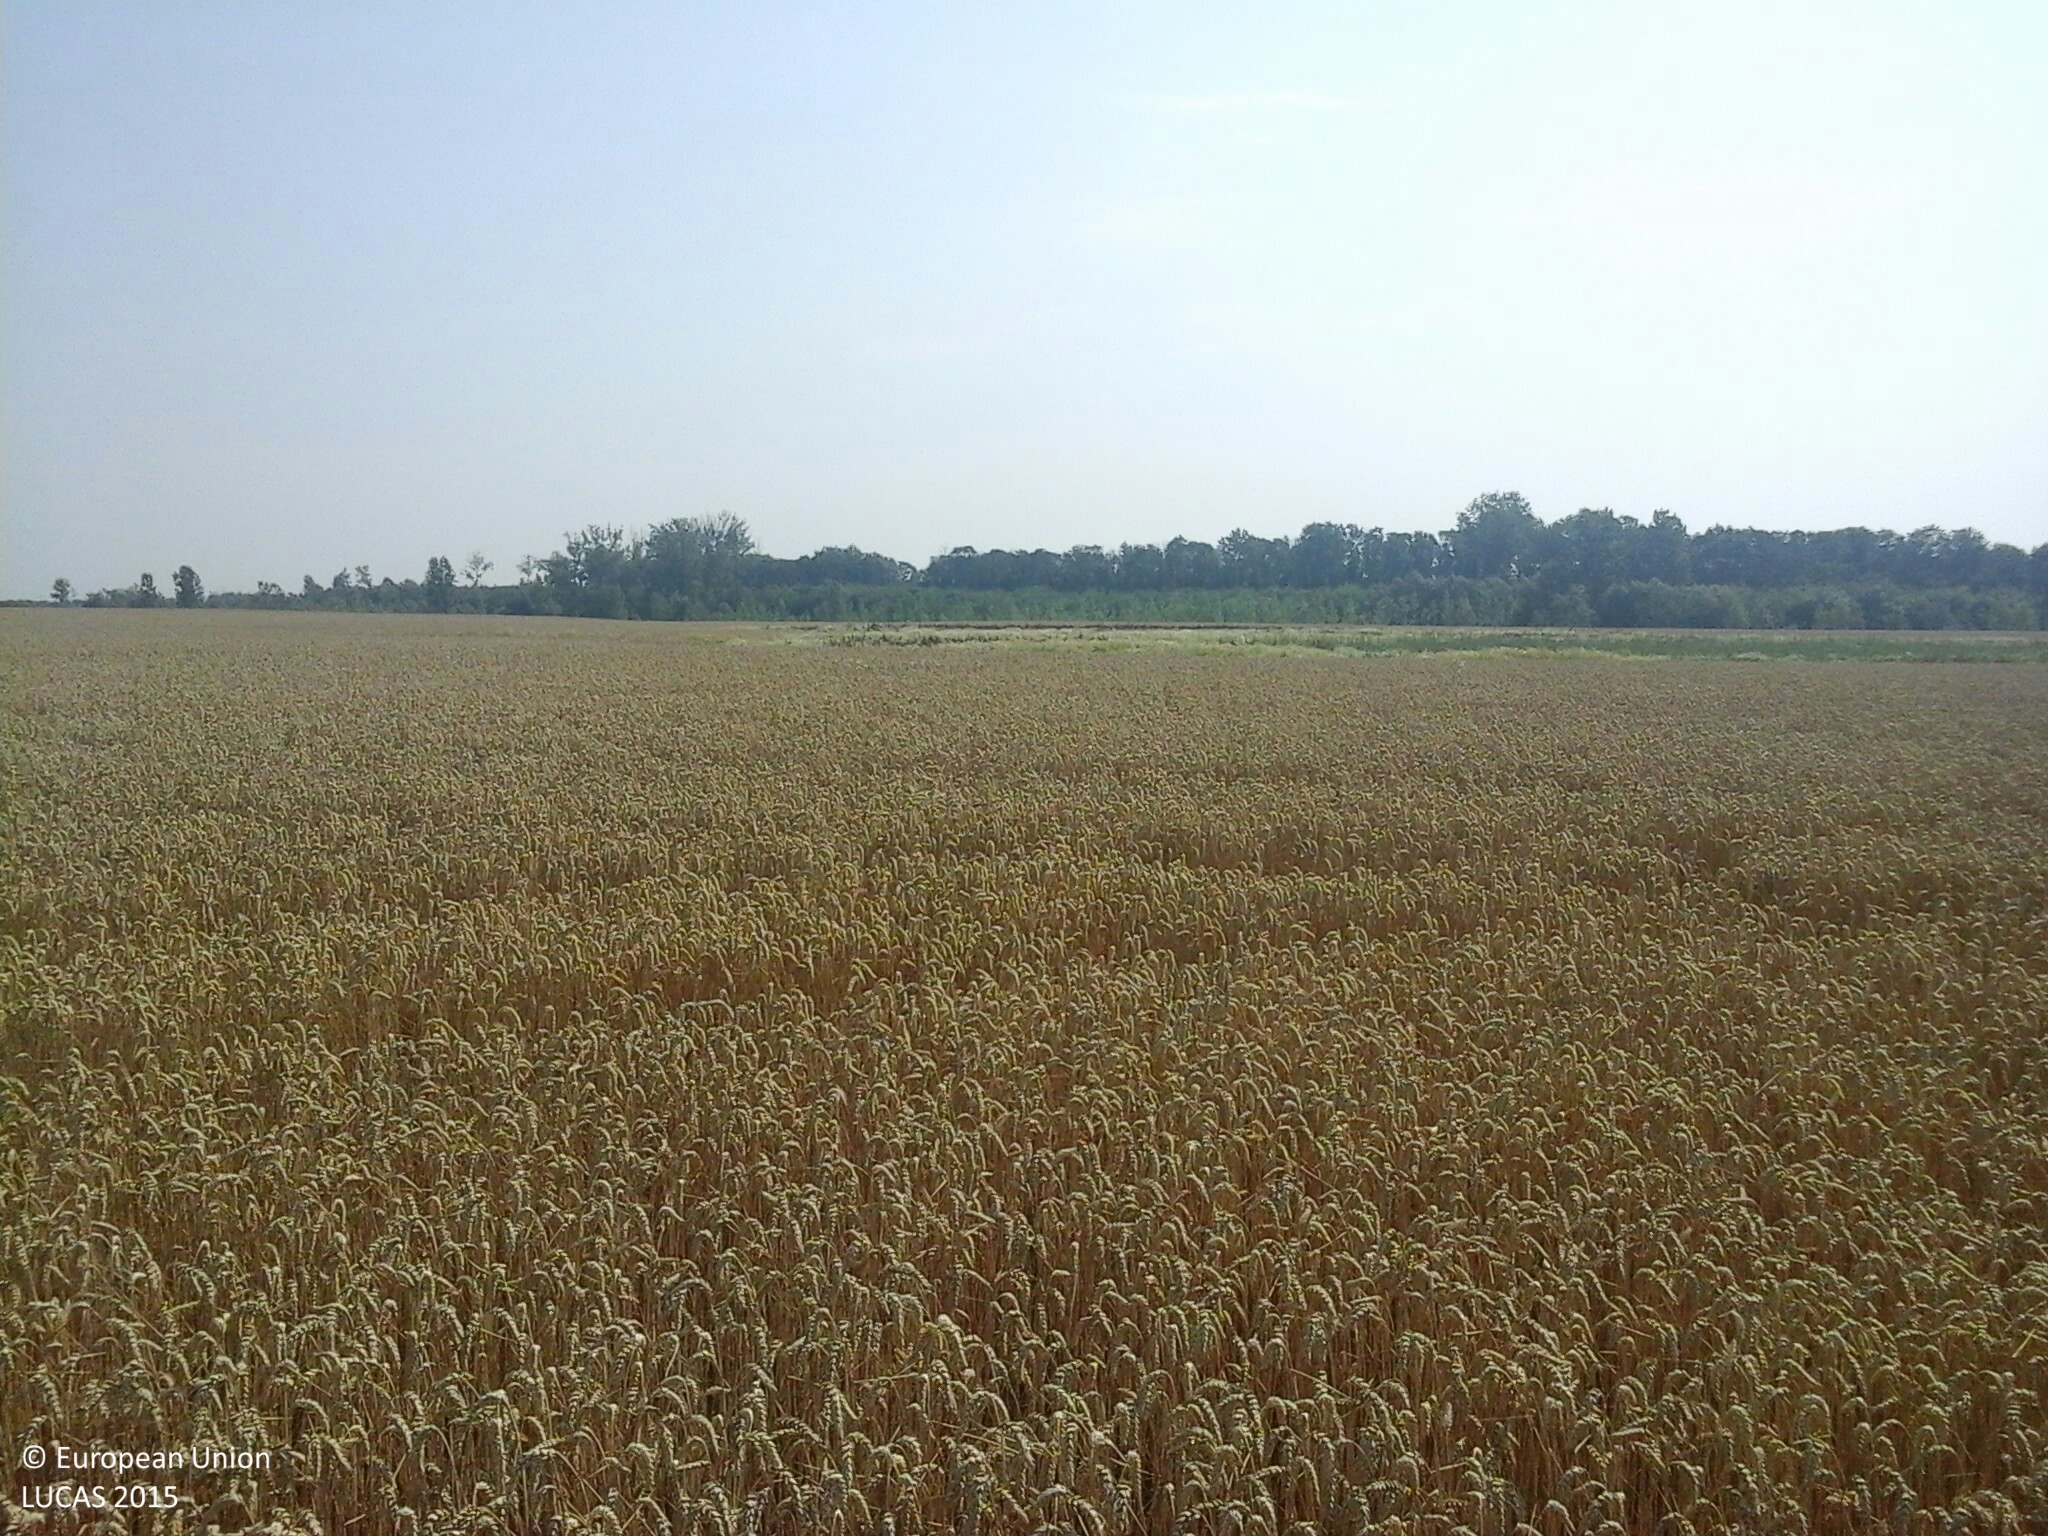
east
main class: Cropland
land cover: Common wheat
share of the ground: > 75 %
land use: Agriculture (excluding fallow land and kitchen gardens)
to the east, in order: Common wheat; Spontaneously vegetated surfaces; Common wheat
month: July
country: HU
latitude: 46.7013
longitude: 20.3449
